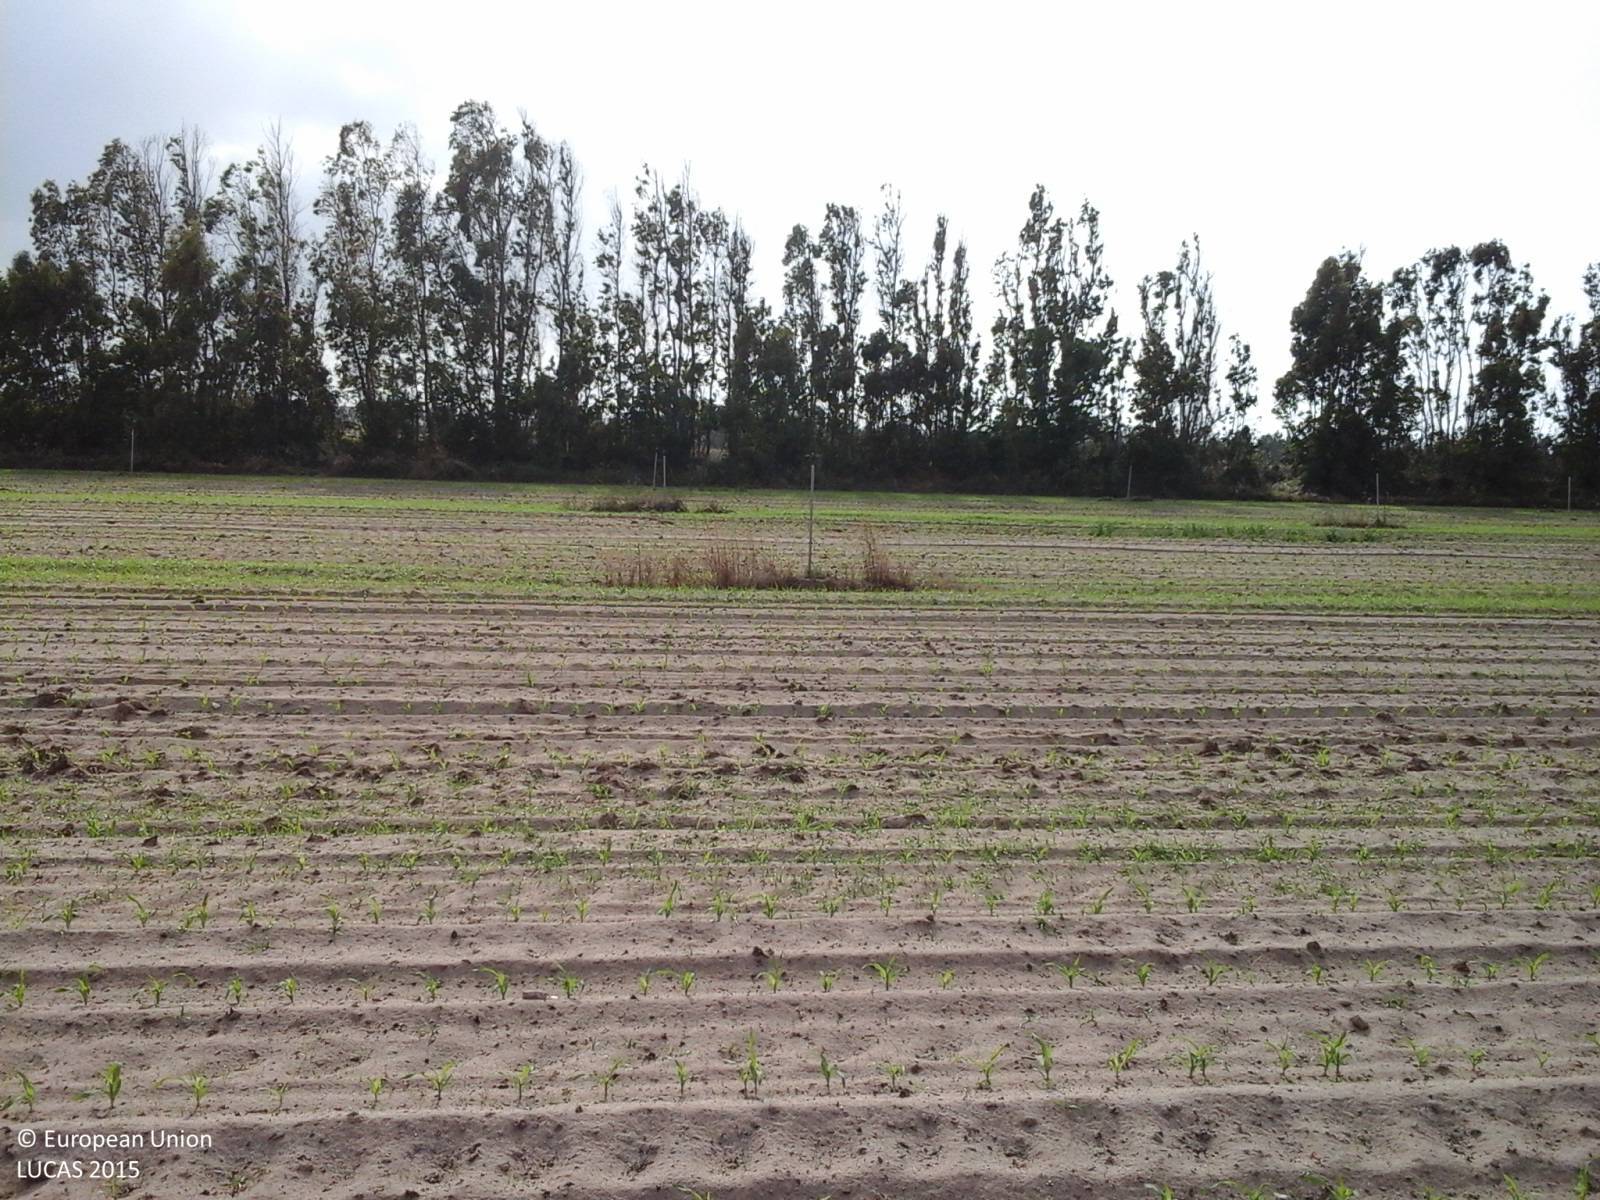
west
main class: Cropland
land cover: Maize
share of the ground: < 10 %
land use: Agriculture (excluding fallow land and kitchen gardens)
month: May
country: IT
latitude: 39.7311
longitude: 8.5266
